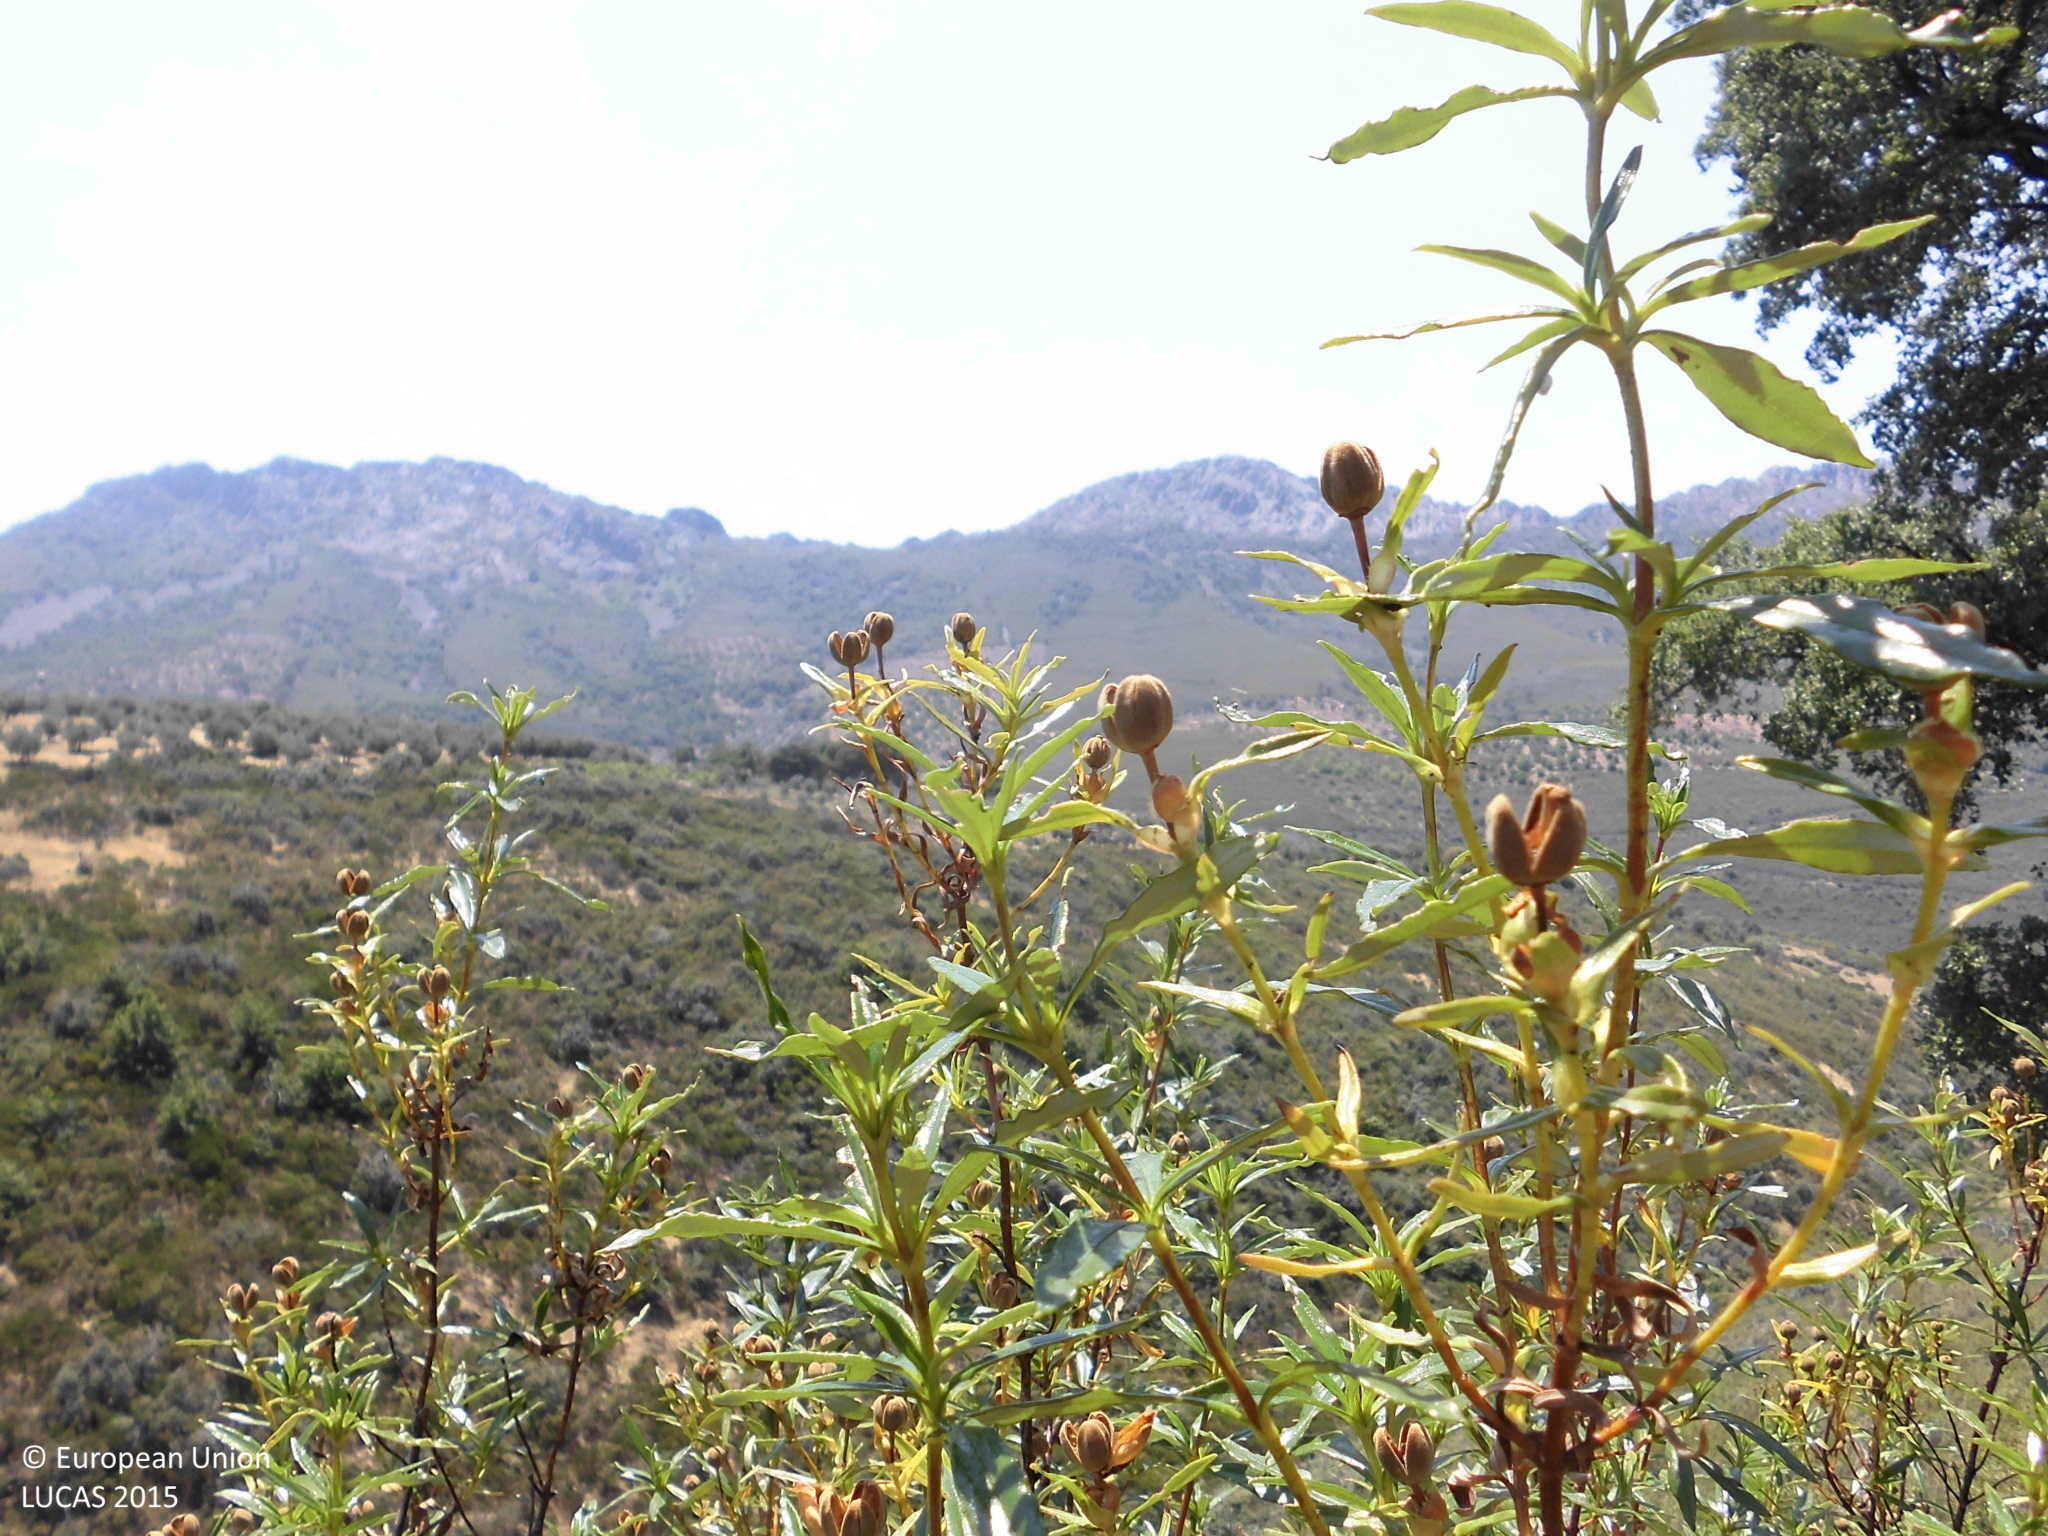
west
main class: Shrubland
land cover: Shrubland without tree cover
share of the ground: > 75 %
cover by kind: shrubs 100 %
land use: Semi-natural and natural areas not in use
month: June
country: ES
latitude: 39.5753
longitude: -5.4066
